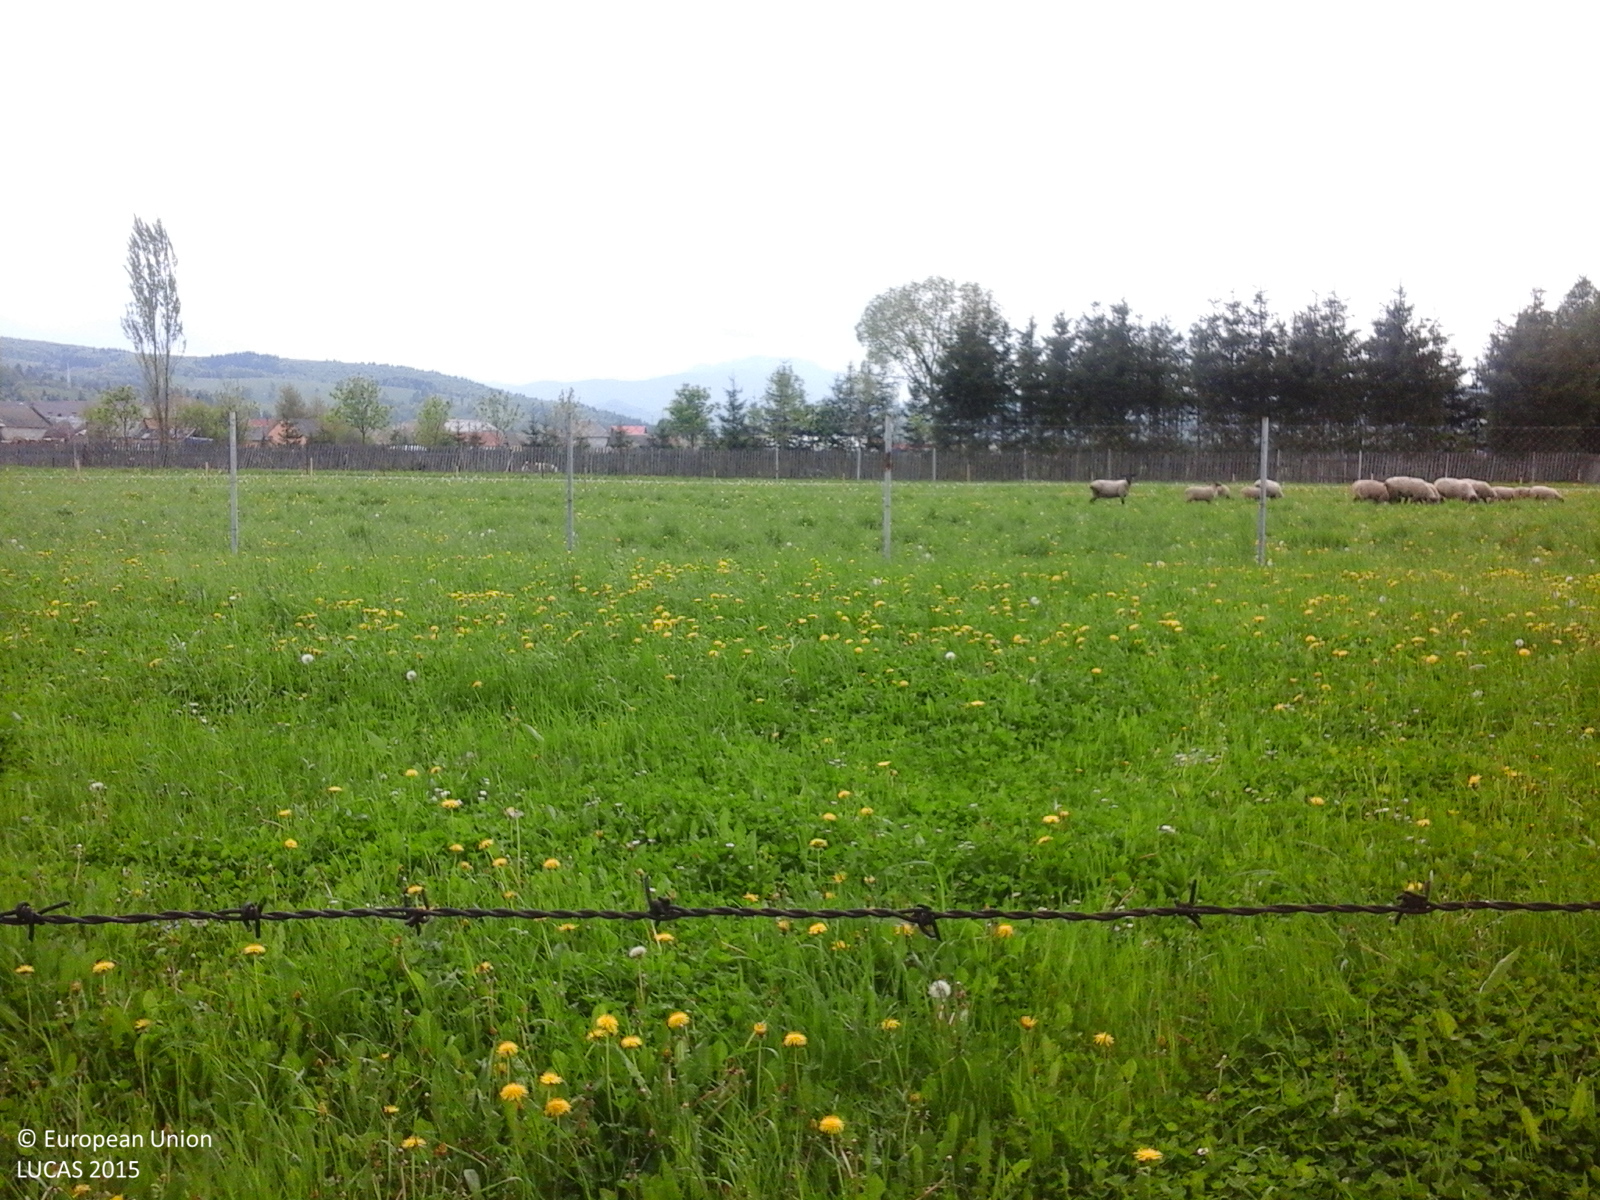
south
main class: Grassland
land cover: Grassland without tree/shrub cover
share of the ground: > 75 %
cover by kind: herbaceous plants 100 %
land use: Agriculture (excluding fallow land and kitchen gardens)
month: May
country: RO
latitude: 45.6662
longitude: 26.0178
